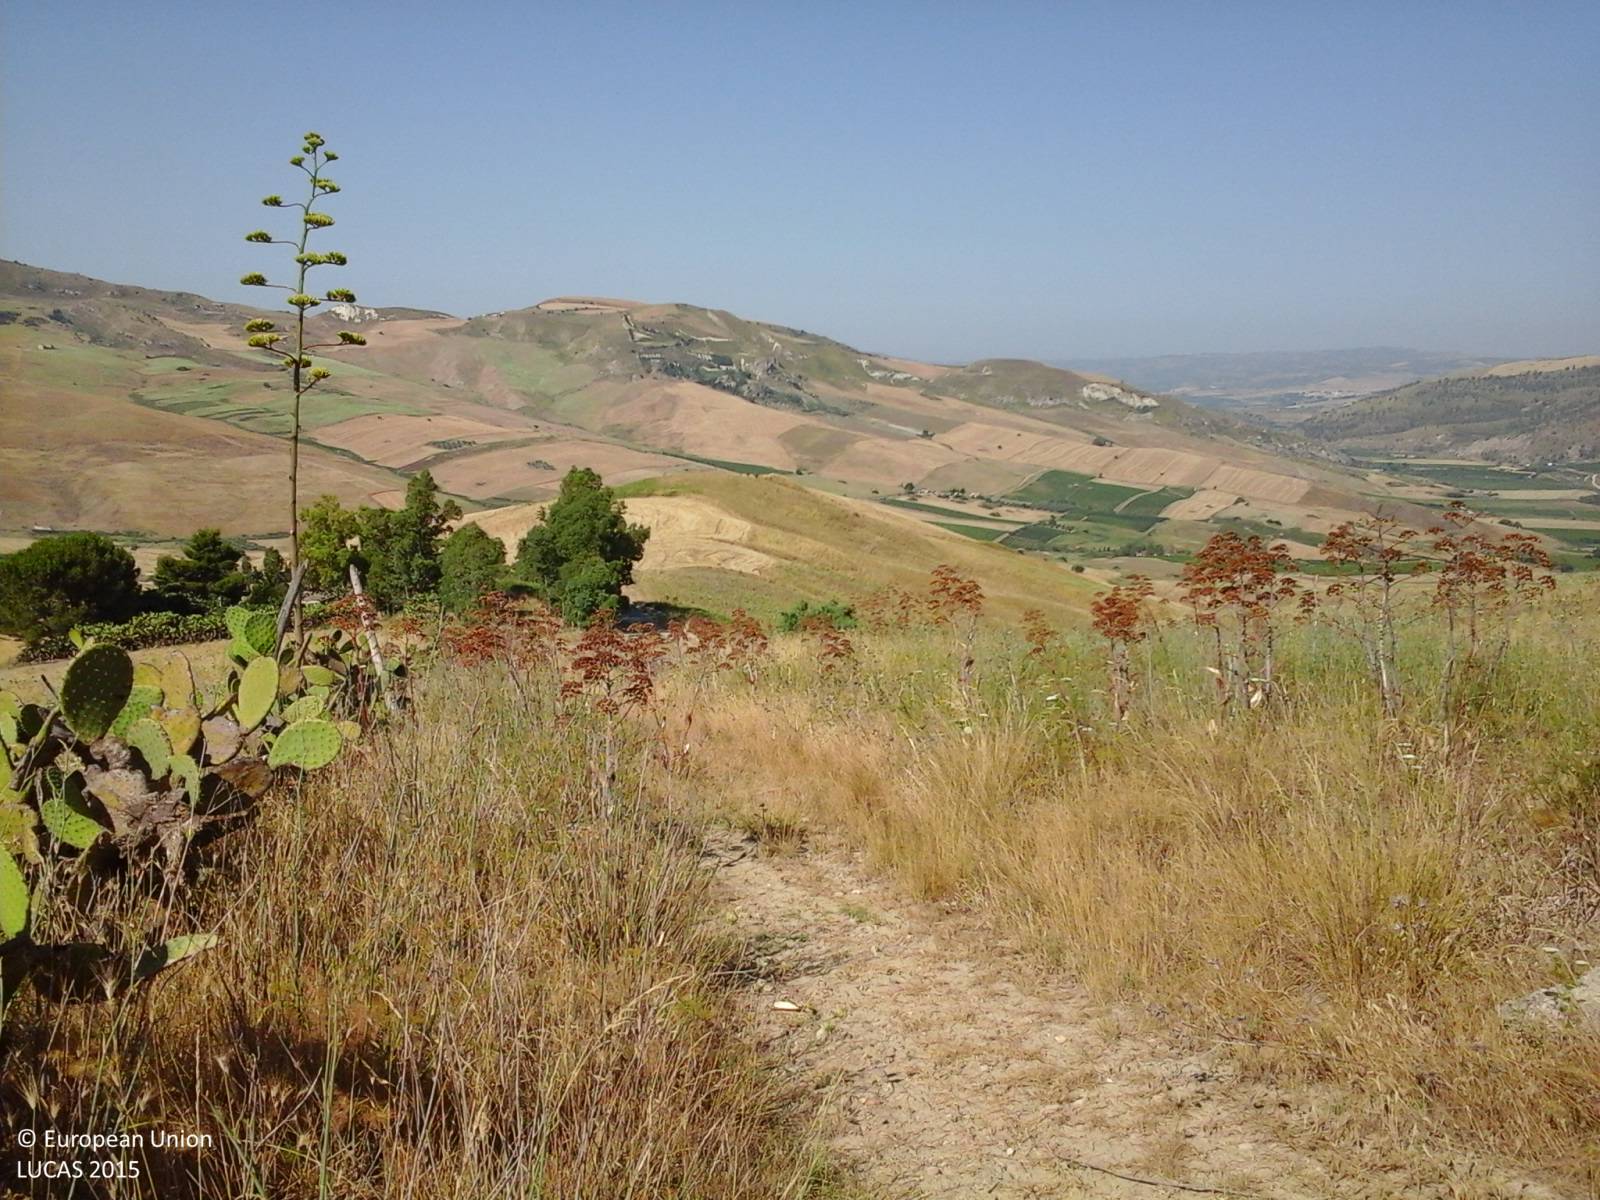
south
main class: Grassland
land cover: Spontaneously vegetated surfaces
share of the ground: > 75 %
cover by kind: herbaceous plants 100 %
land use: Fallow land
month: July
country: IT
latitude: 37.7690
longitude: 13.1215
